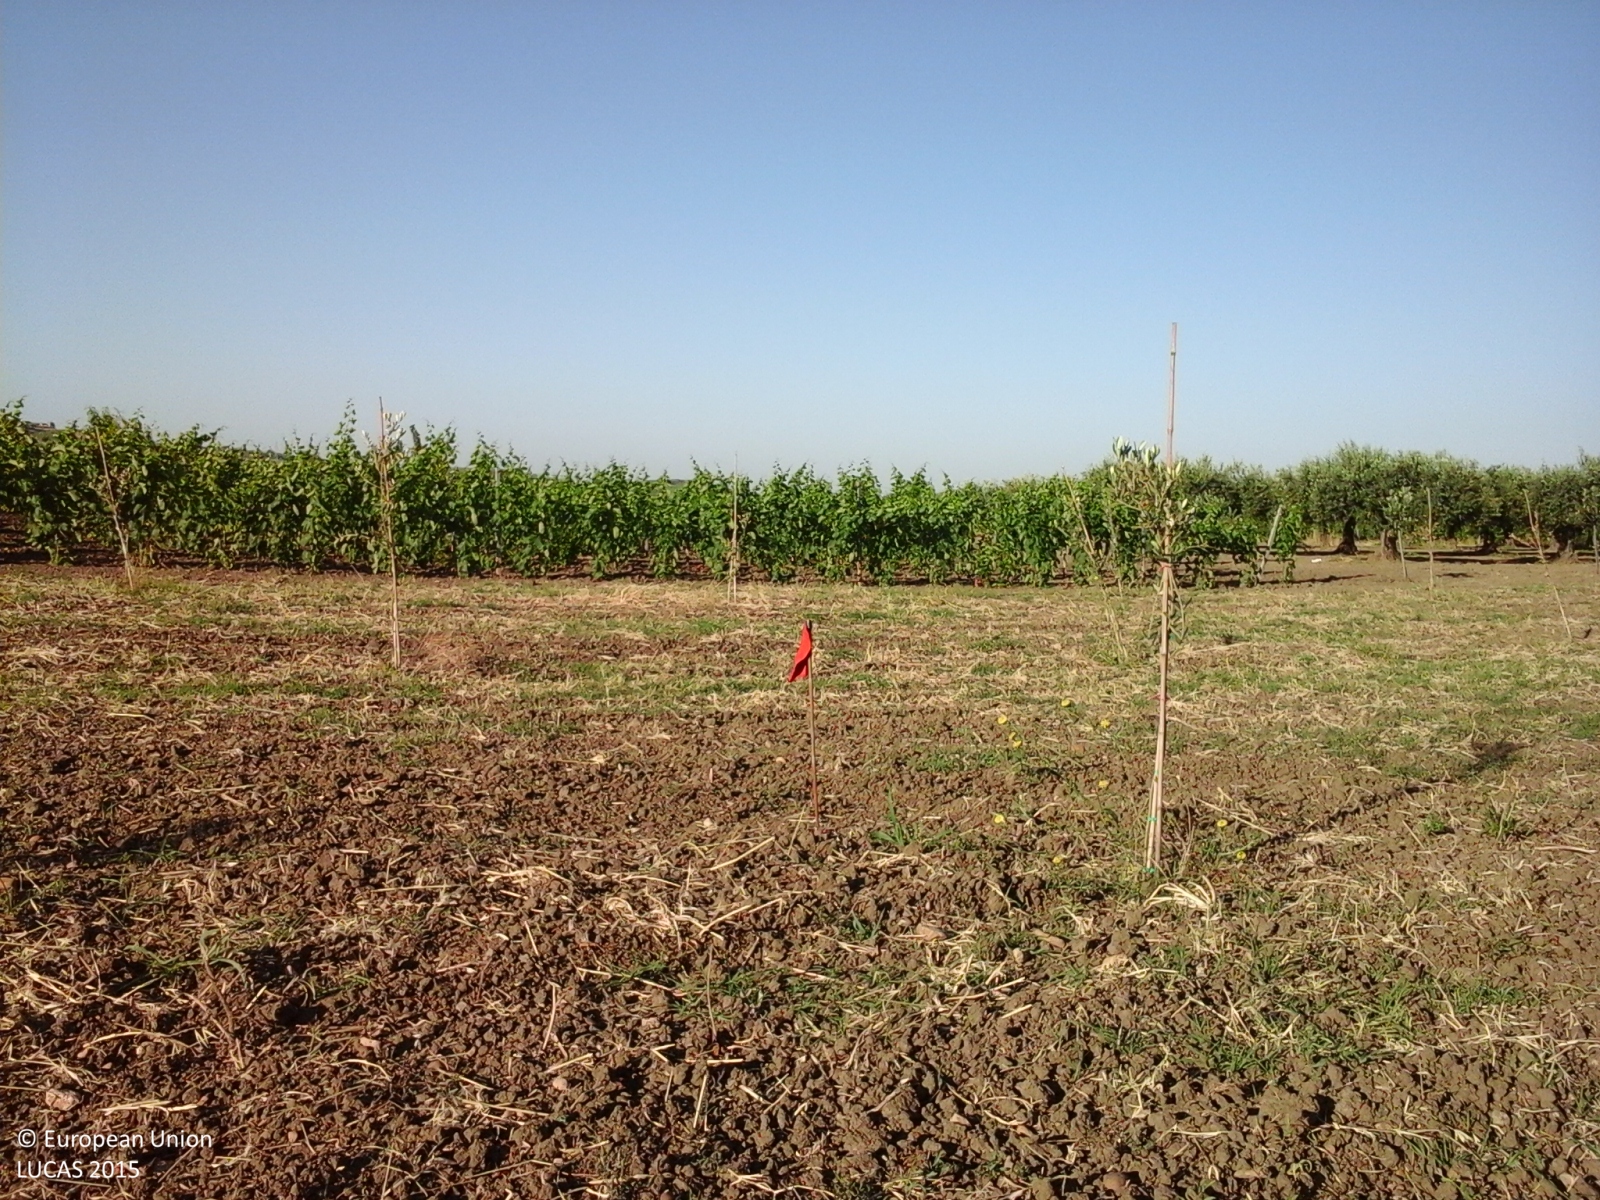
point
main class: Cropland
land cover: Olive groves
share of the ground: < 10 %
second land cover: Spontaneously vegetated surfaces
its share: < 10 %
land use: Agriculture (excluding fallow land and kitchen gardens)
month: June
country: IT
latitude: 37.7231
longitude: 12.8490
